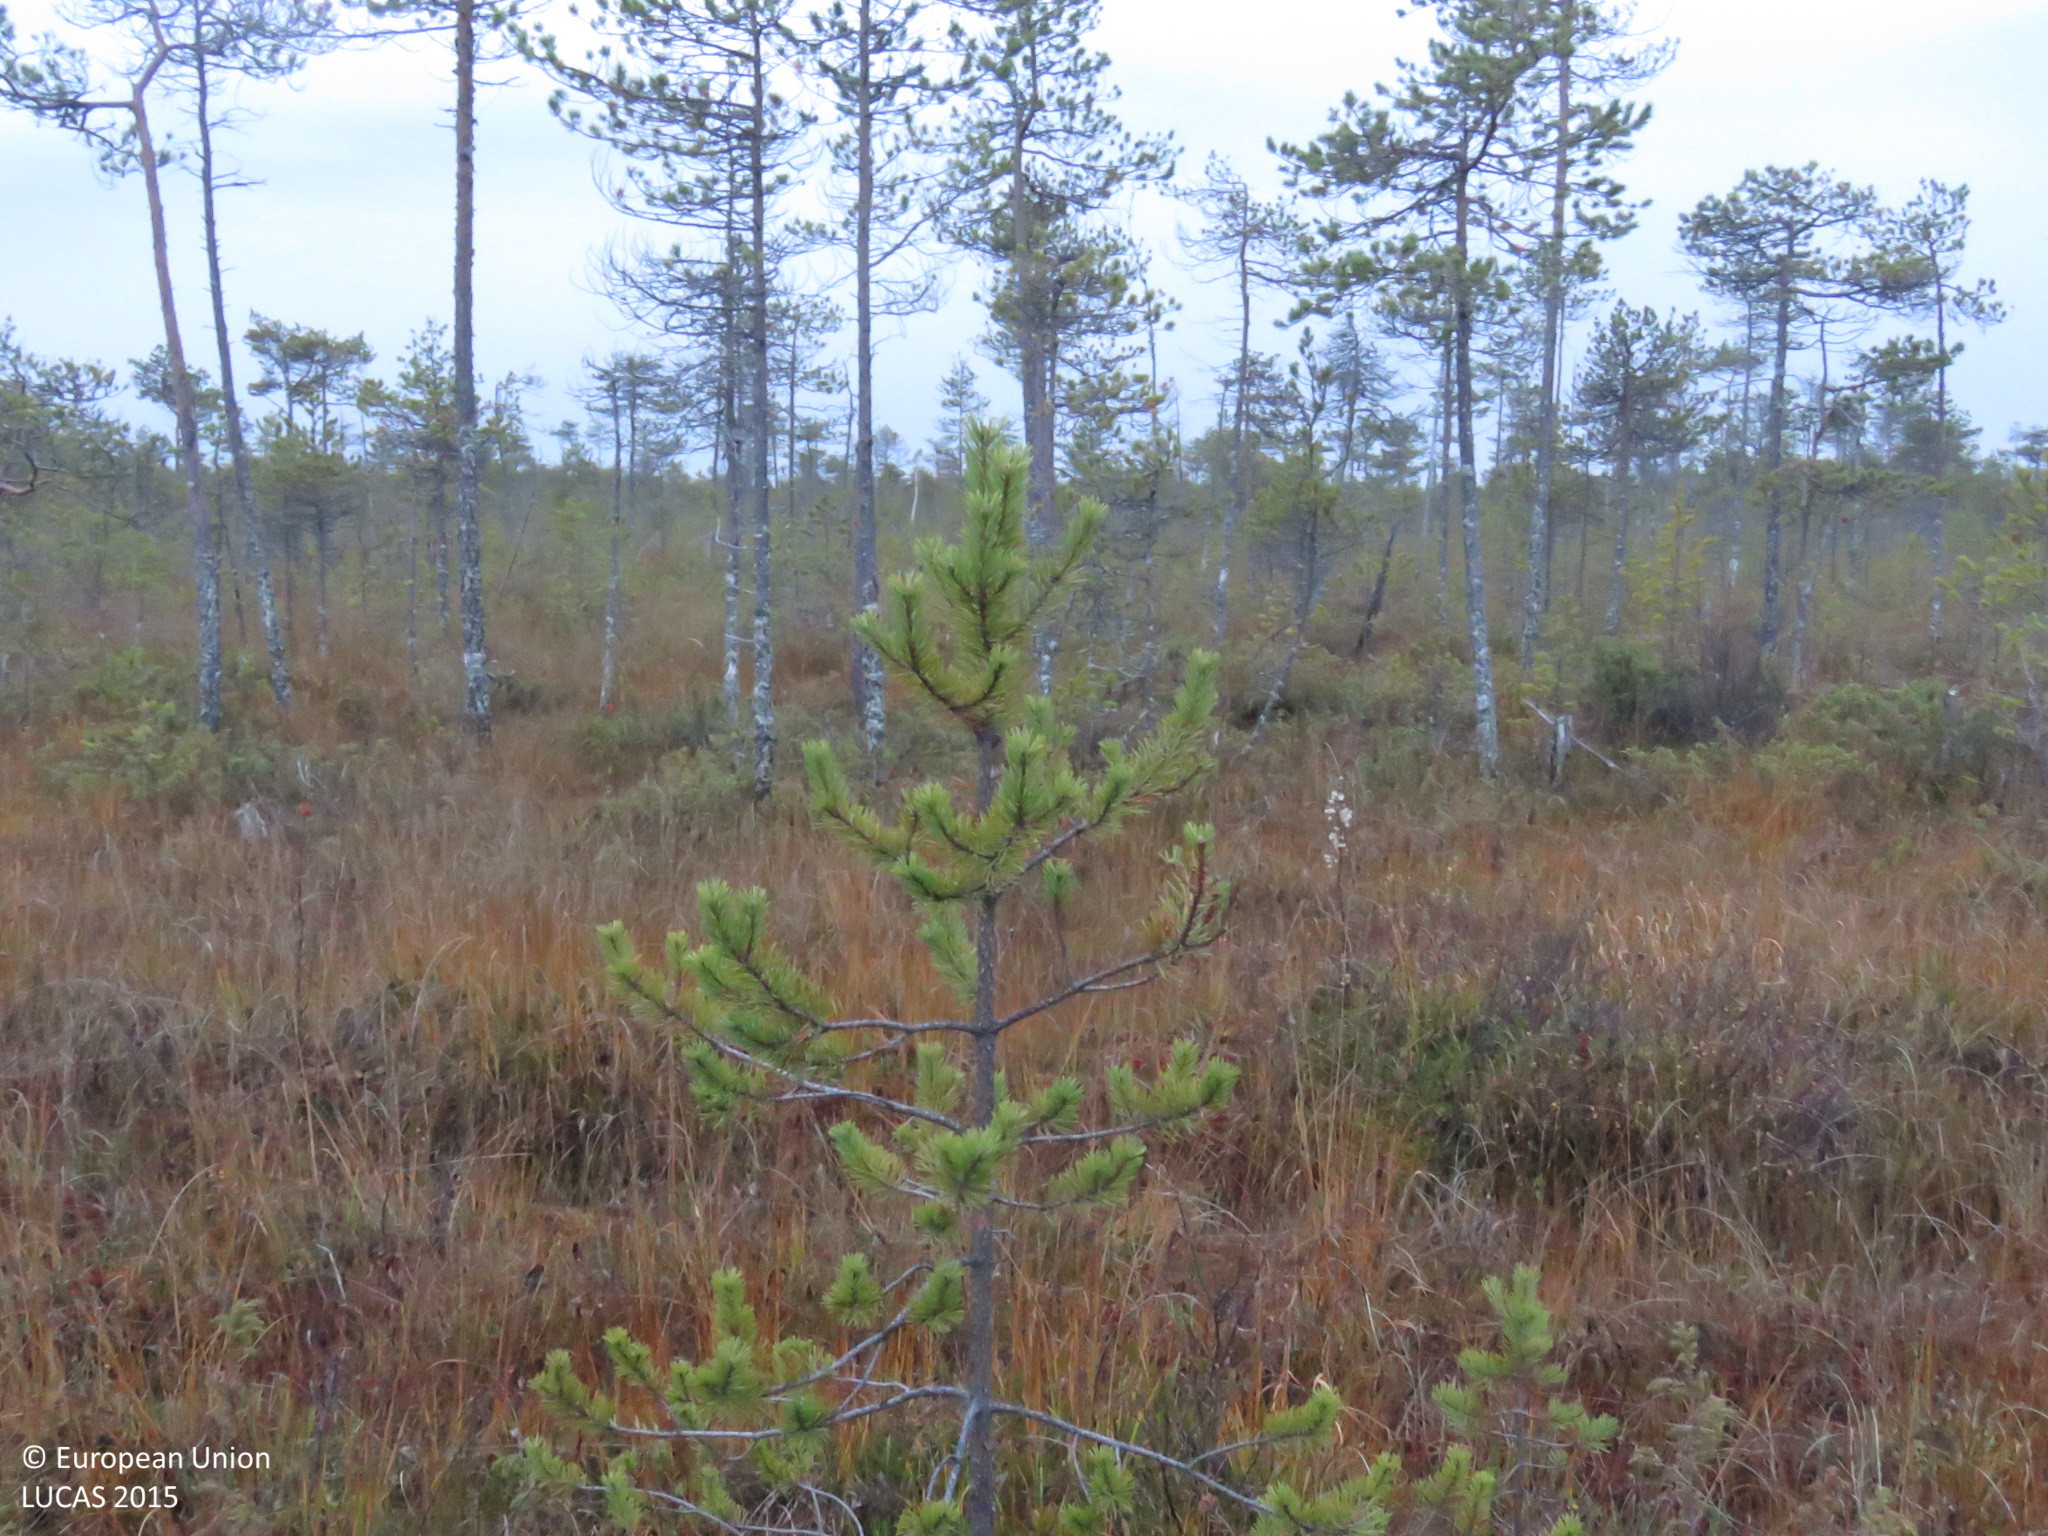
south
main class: Woodland
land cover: Pine dominated coniferous woodland
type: mire and swamp forests
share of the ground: 25 - 50 %
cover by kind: coniferous forest trees 40 %, shrubs 25 %, herbaceous plants 25 %, lichens and mosses 10 %
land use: Semi-natural and natural areas not in use
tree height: < 5 m
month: September
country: FI
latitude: 65.2662
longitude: 27.2395
